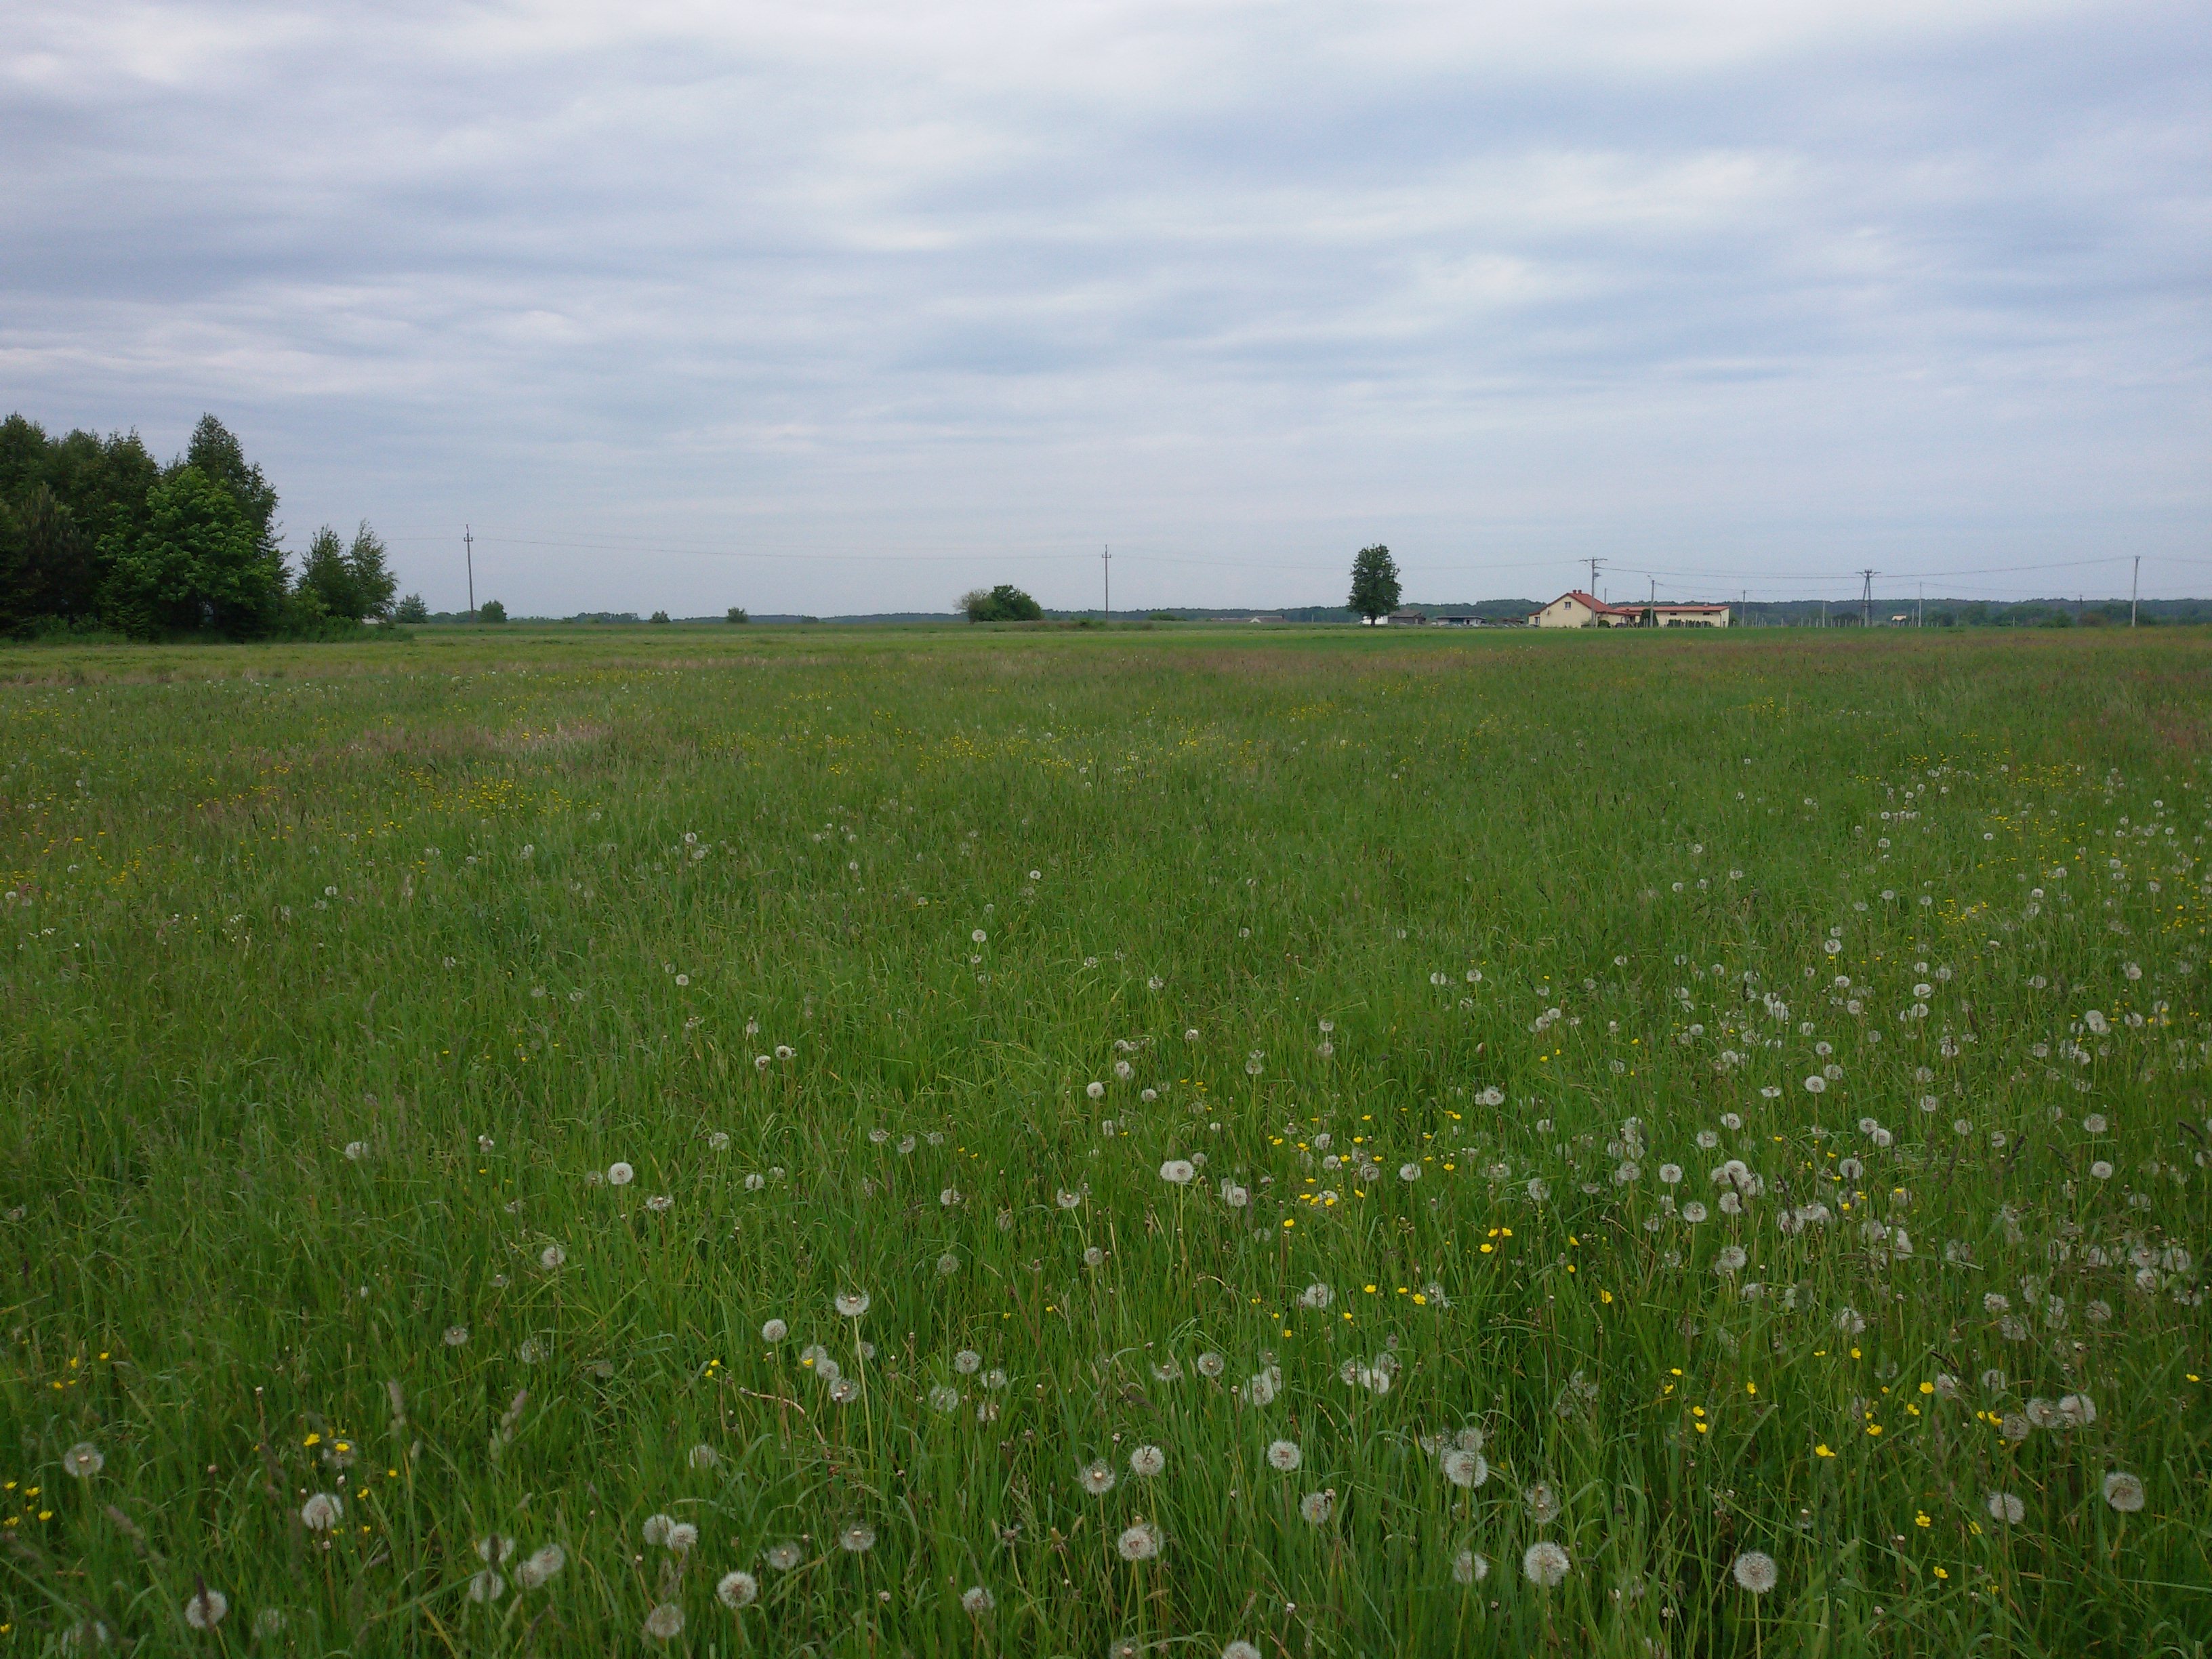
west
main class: Grassland
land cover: Grassland without tree/shrub cover
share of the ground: > 75 %
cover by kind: herbaceous plants 100 %
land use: Agriculture (excluding fallow land and kitchen gardens)
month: May
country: PL
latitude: 51.7260
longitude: 21.6791
